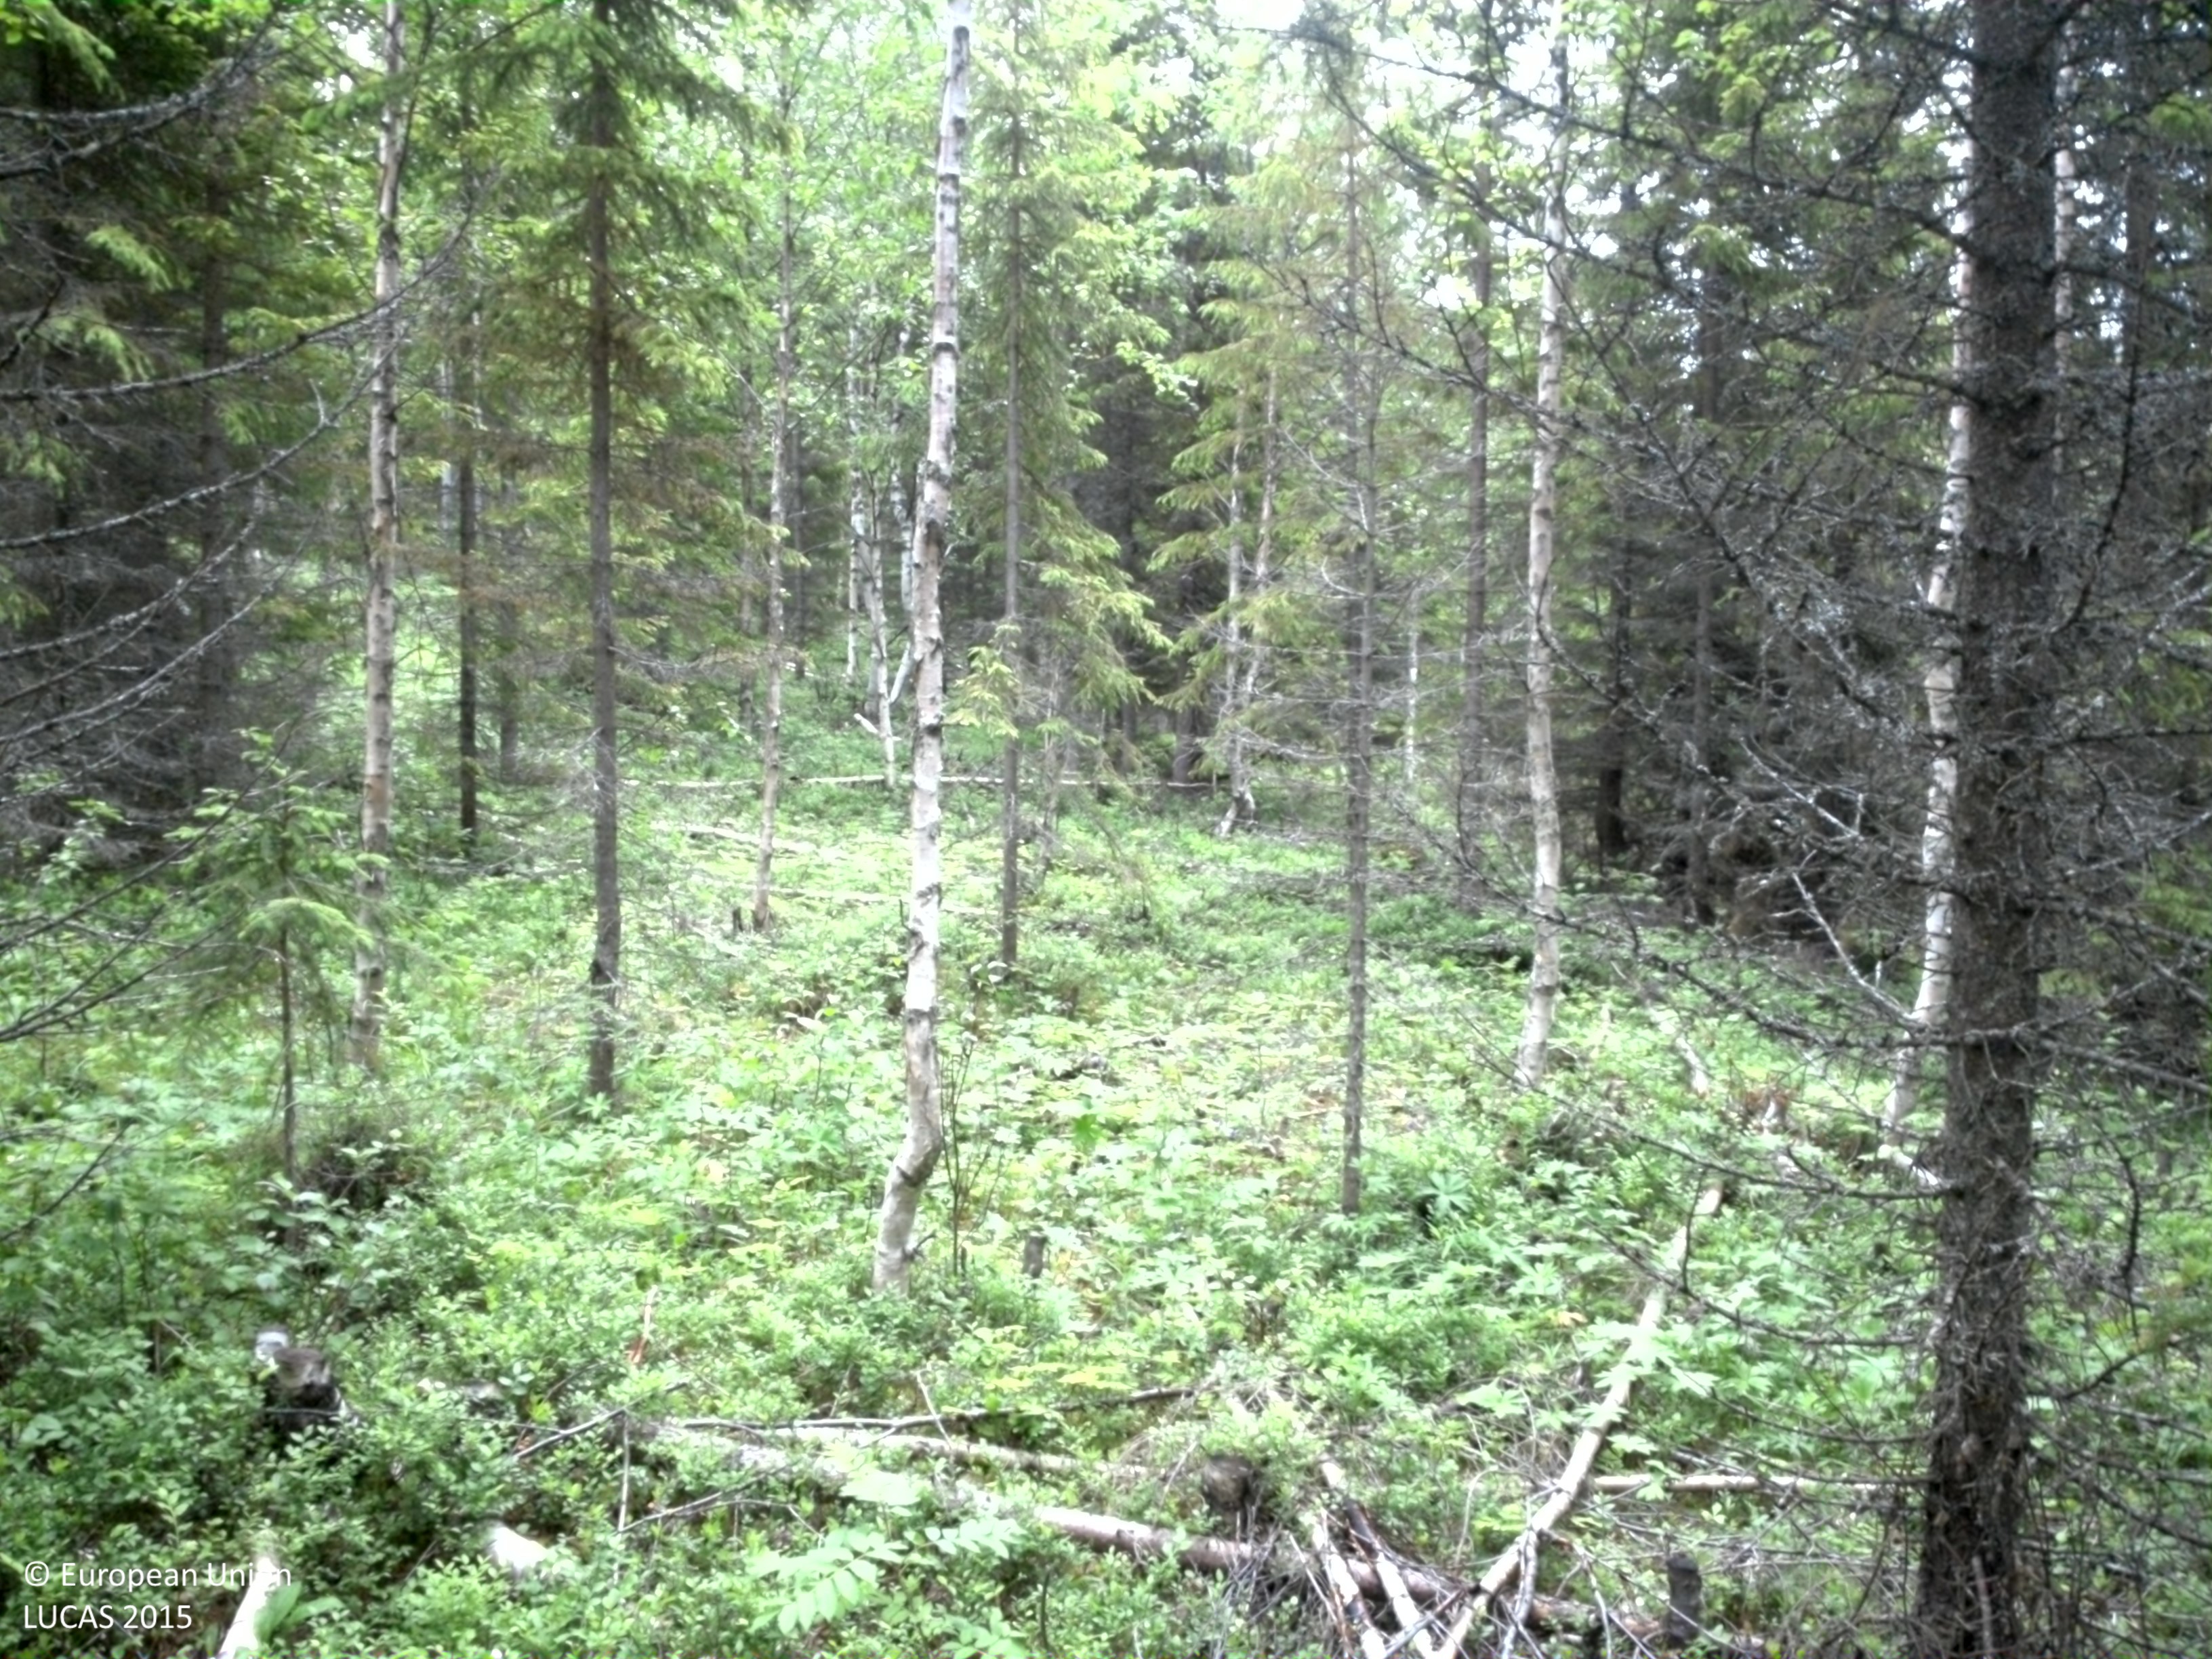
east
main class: Woodland
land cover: Spruce dominated mixed woodland
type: boreal forest
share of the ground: 50 - 75 %
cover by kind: coniferous forest trees 45 %, shrubs 30 %, broadleaved forest trees 15 %, herbaceous plants 10 %
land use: Forestry
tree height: > 5 m
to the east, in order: Spruce dominated mixed woodland
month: July
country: SE
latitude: 64.5333
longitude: 18.1591
